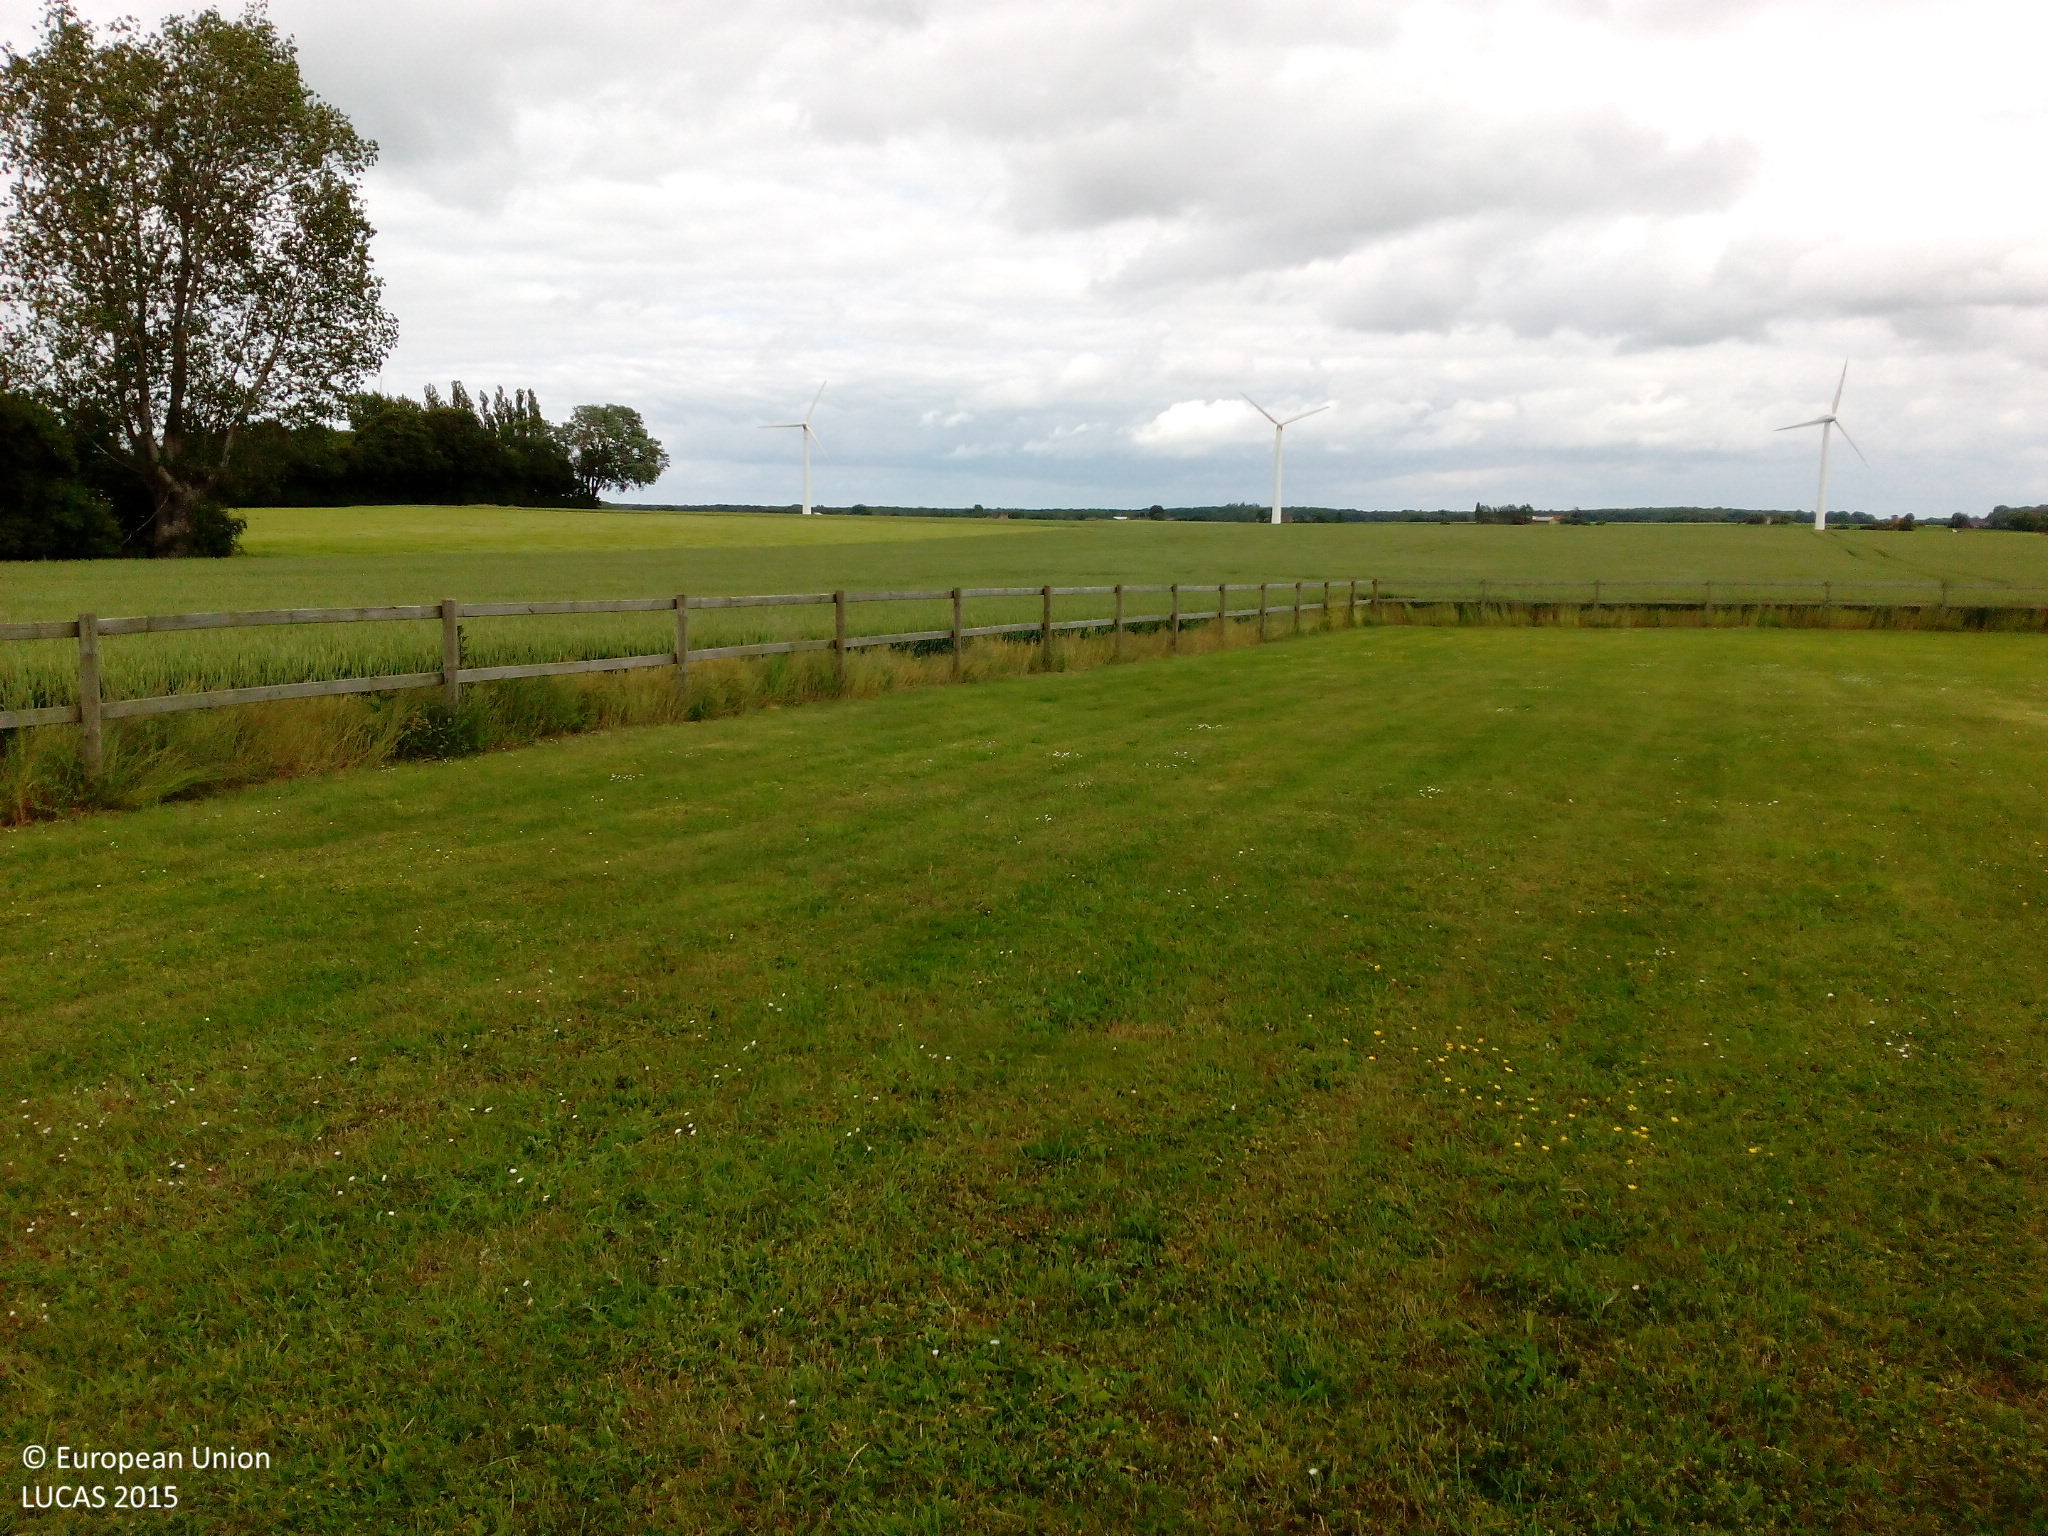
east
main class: Grassland
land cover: Grassland without tree/shrub cover
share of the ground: > 75 %
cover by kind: herbaceous plants 100 %
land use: Agriculture (excluding fallow land and kitchen gardens)
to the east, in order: Grassland without tree/shrub cover; Fences; Grass margins; Common wheat
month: June
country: DK
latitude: 54.8470
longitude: 11.6341
